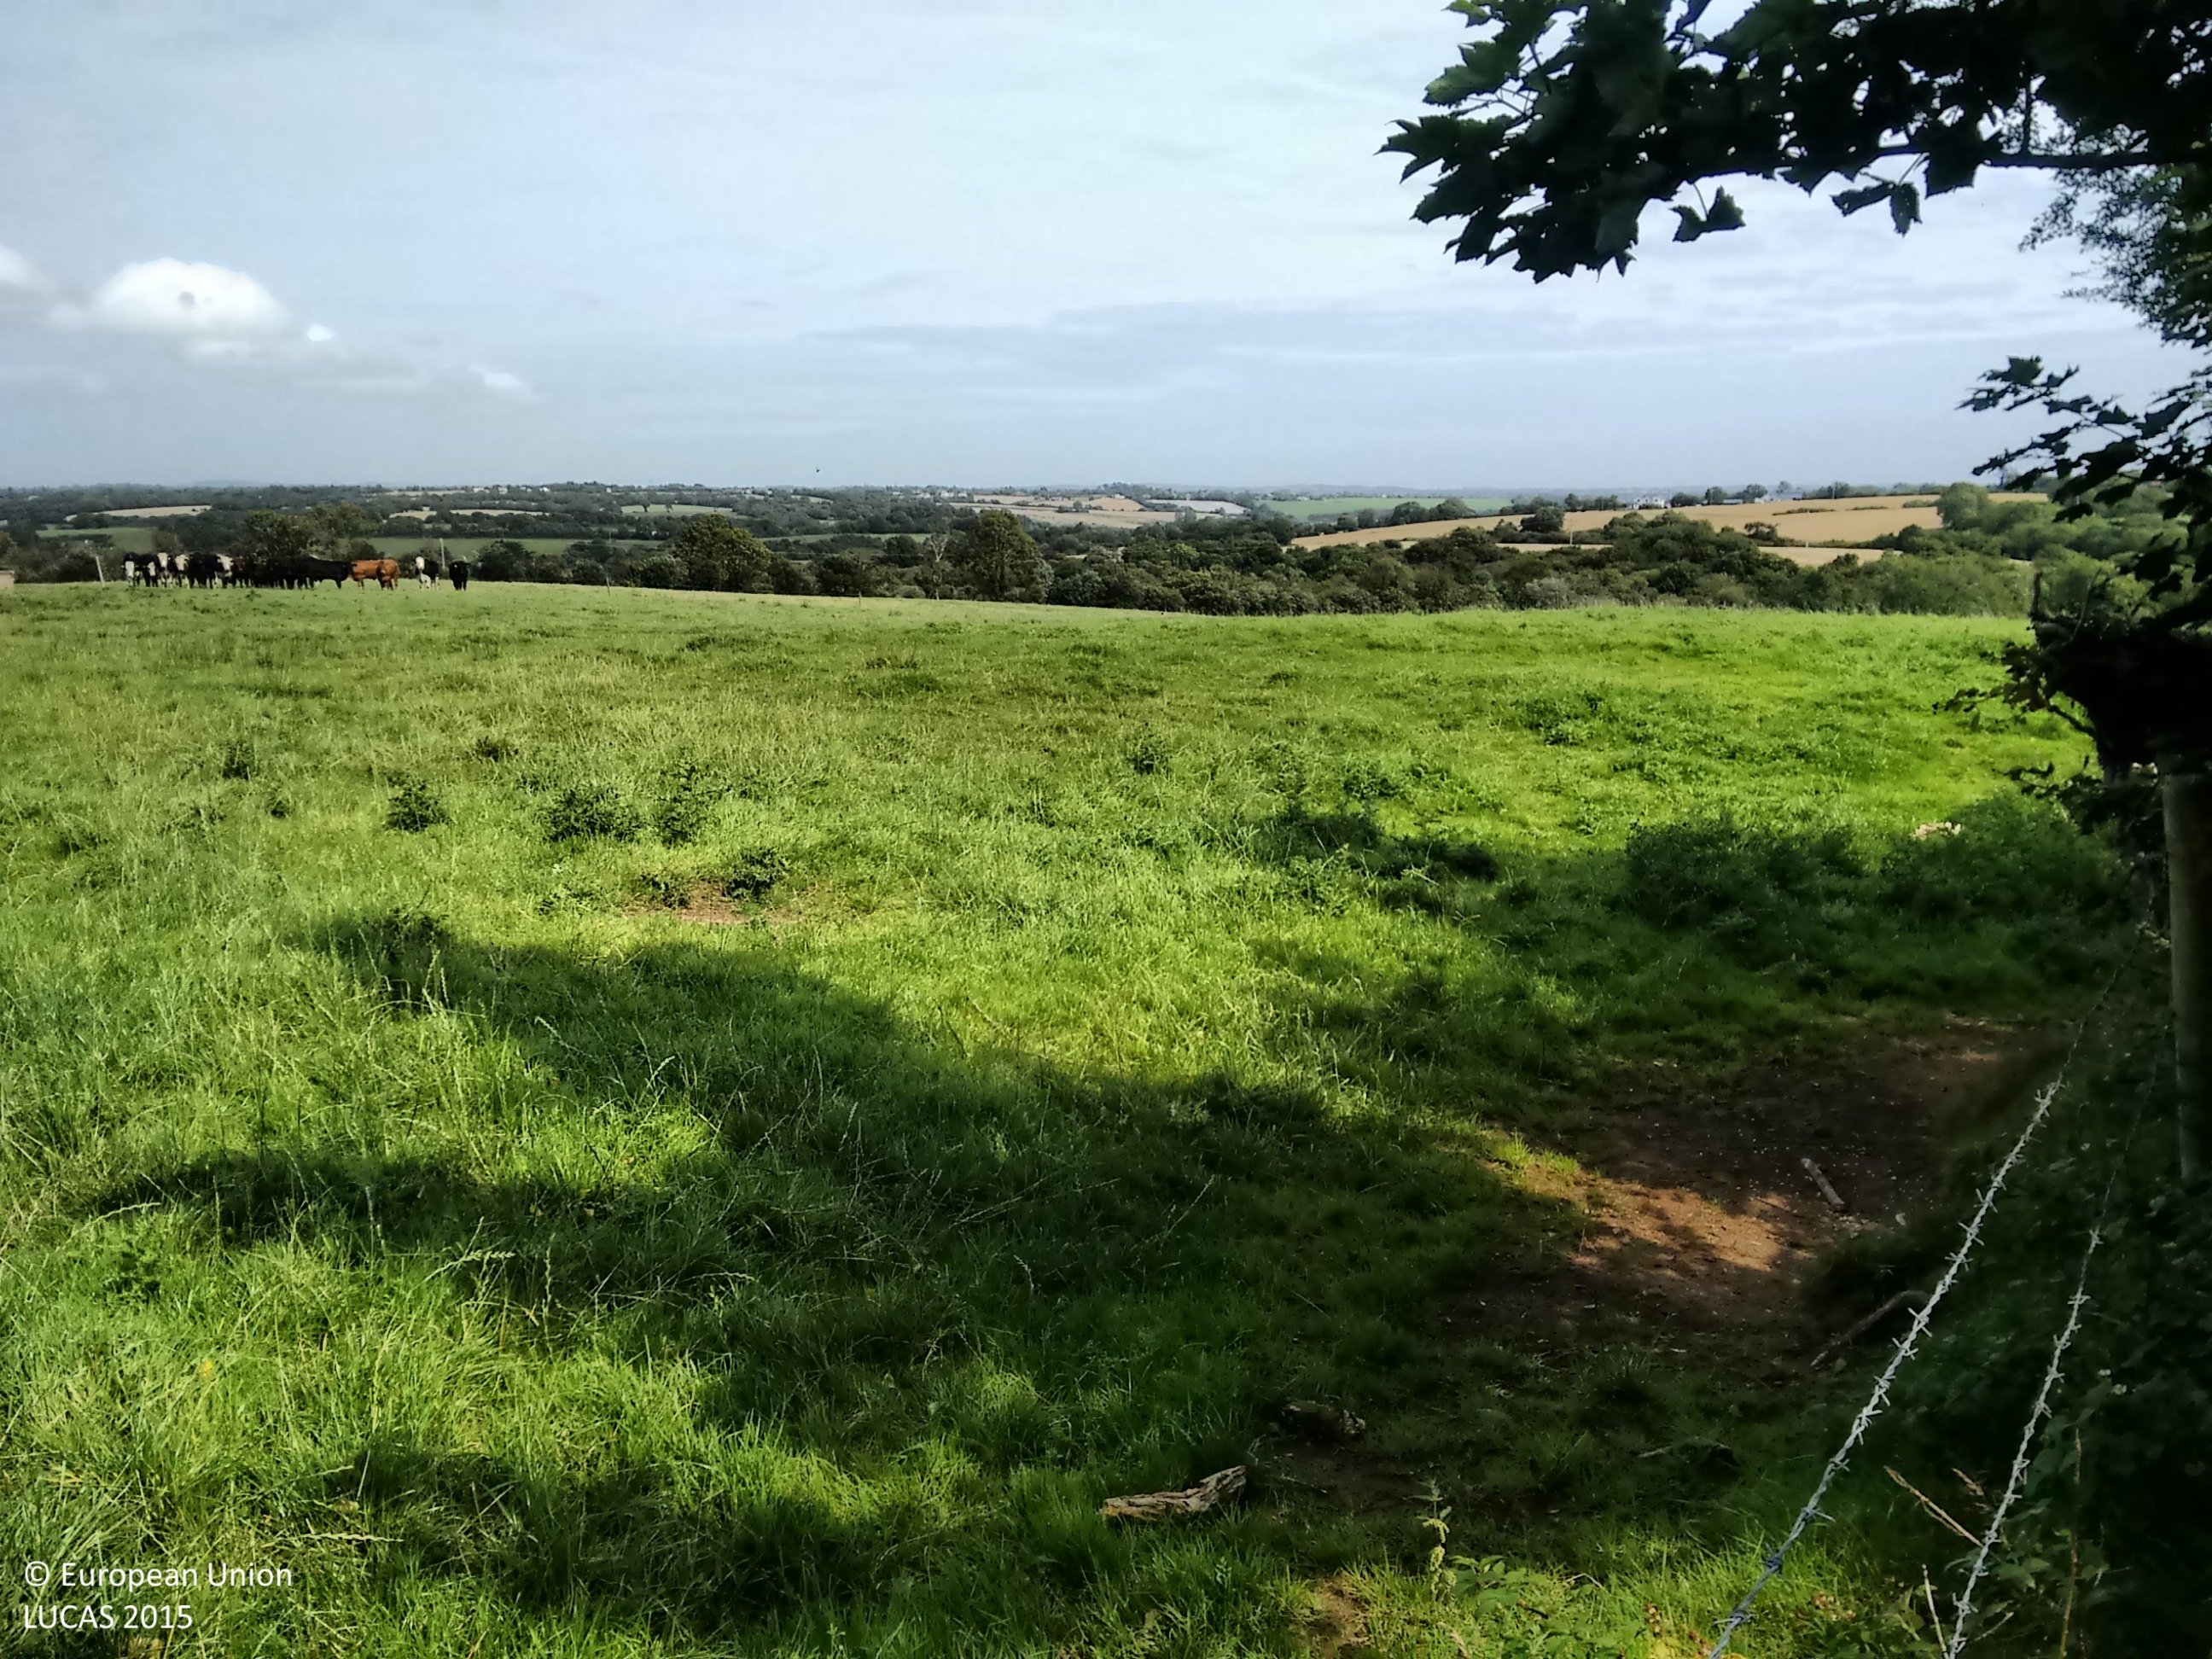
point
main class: Grassland
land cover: Grassland without tree/shrub cover
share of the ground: > 75 %
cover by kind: herbaceous plants 100 %
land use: Agriculture (excluding fallow land and kitchen gardens)
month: August
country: IE
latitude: 52.3426
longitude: -6.5546
